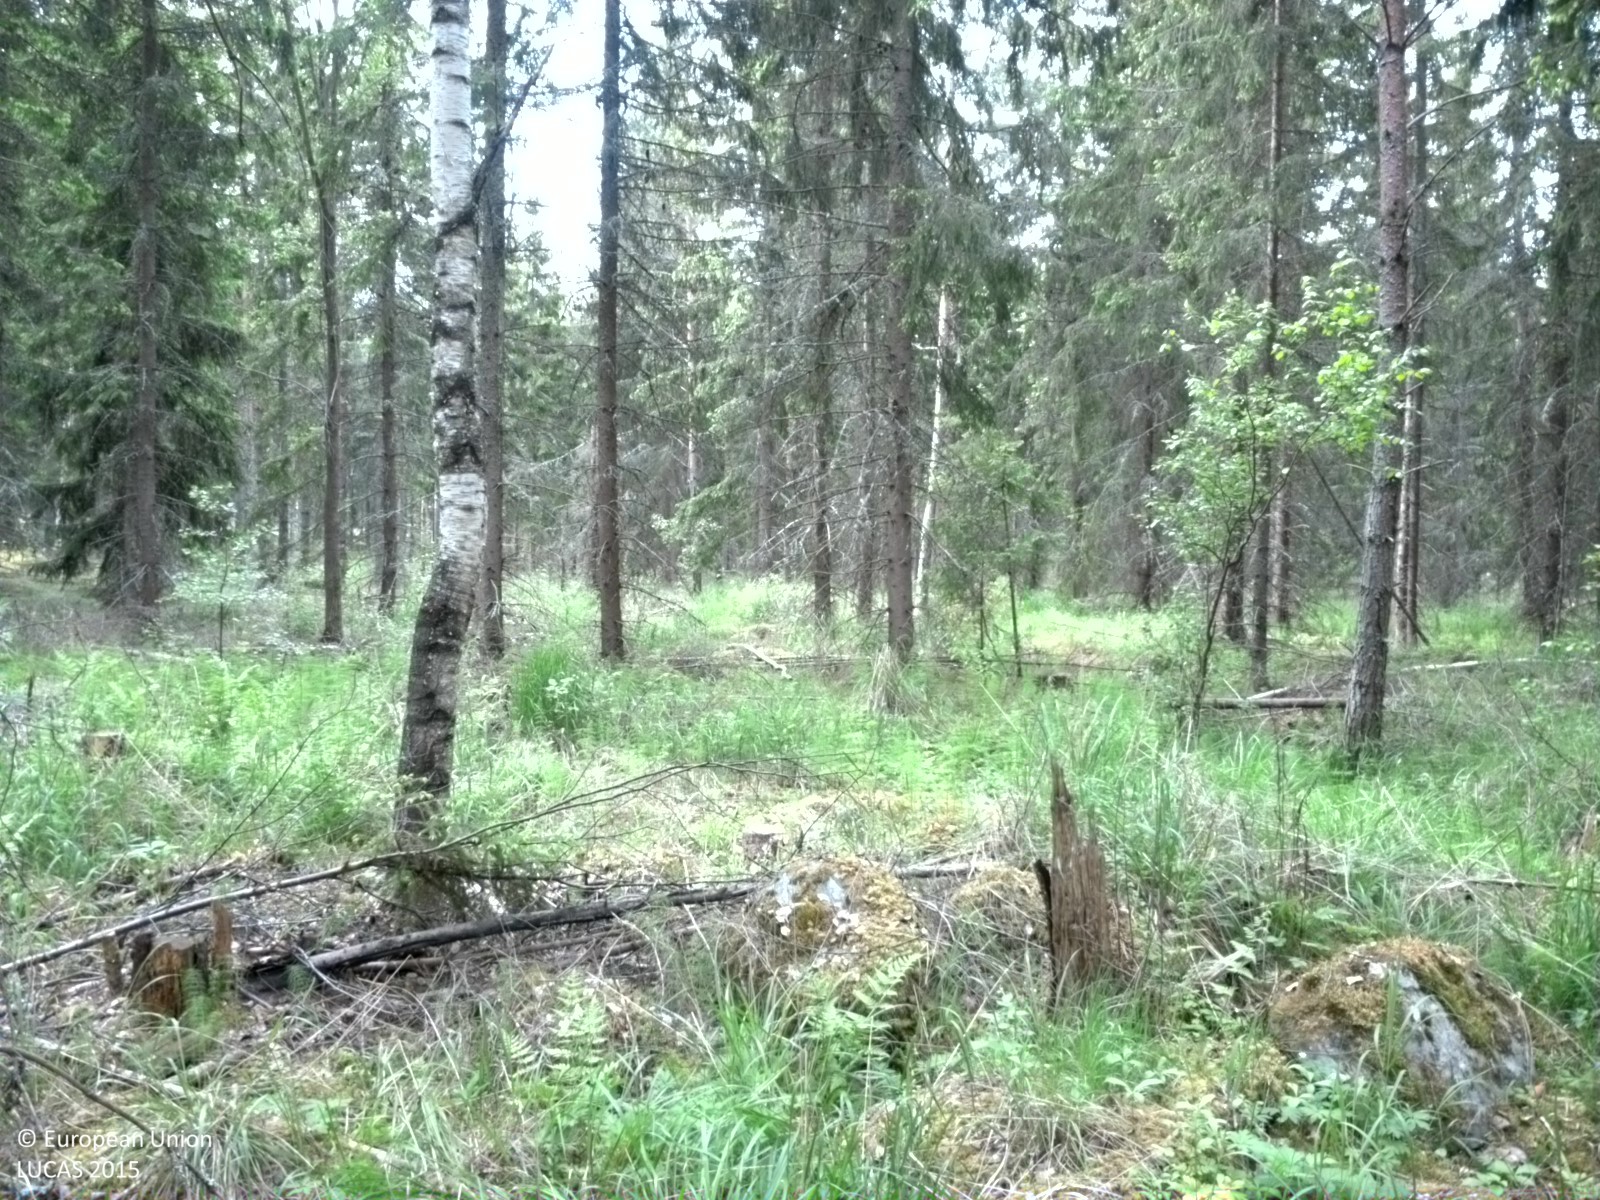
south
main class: Woodland
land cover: Spruce dominated coniferous woodland
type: boreal forest
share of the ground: 50 - 75 %
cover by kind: coniferous forest trees 60 %, herbaceous plants 25 %, broadleaved forest trees 5 %, lichens and mosses 5 %
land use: Forestry
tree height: > 5 m
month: June
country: SE
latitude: 60.2769
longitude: 17.0242
